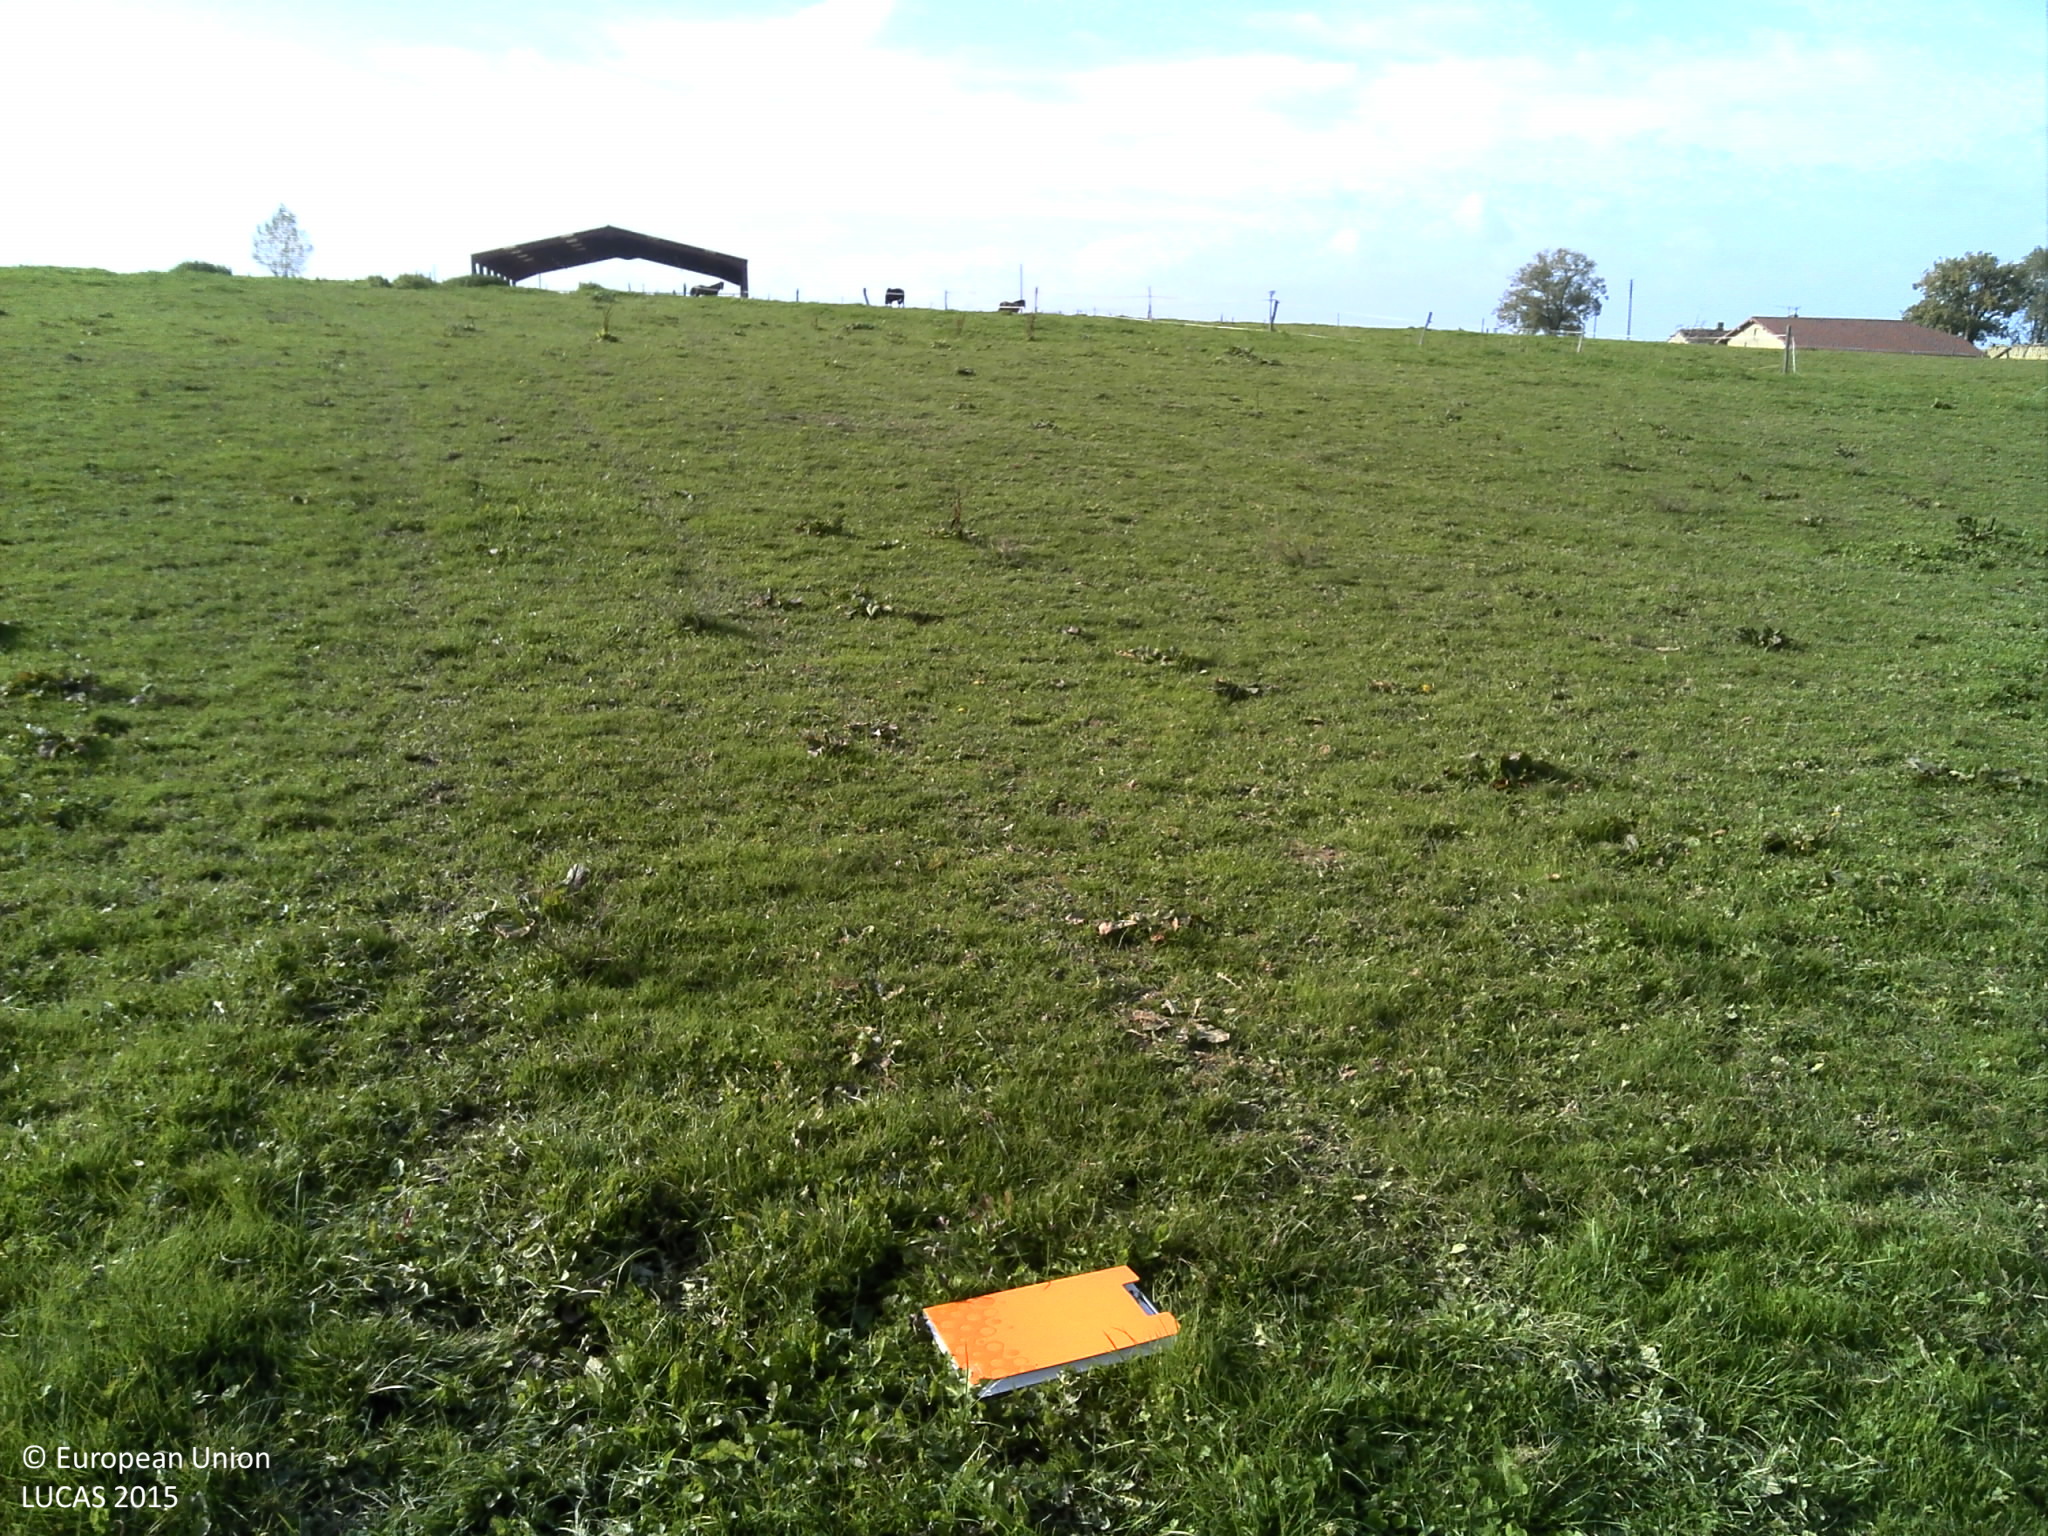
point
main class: Grassland
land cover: Grassland without tree/shrub cover
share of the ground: > 75 %
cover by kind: herbaceous plants 100 %
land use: Agriculture (excluding fallow land and kitchen gardens)
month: October
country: FR
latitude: 46.2668
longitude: 5.3190
